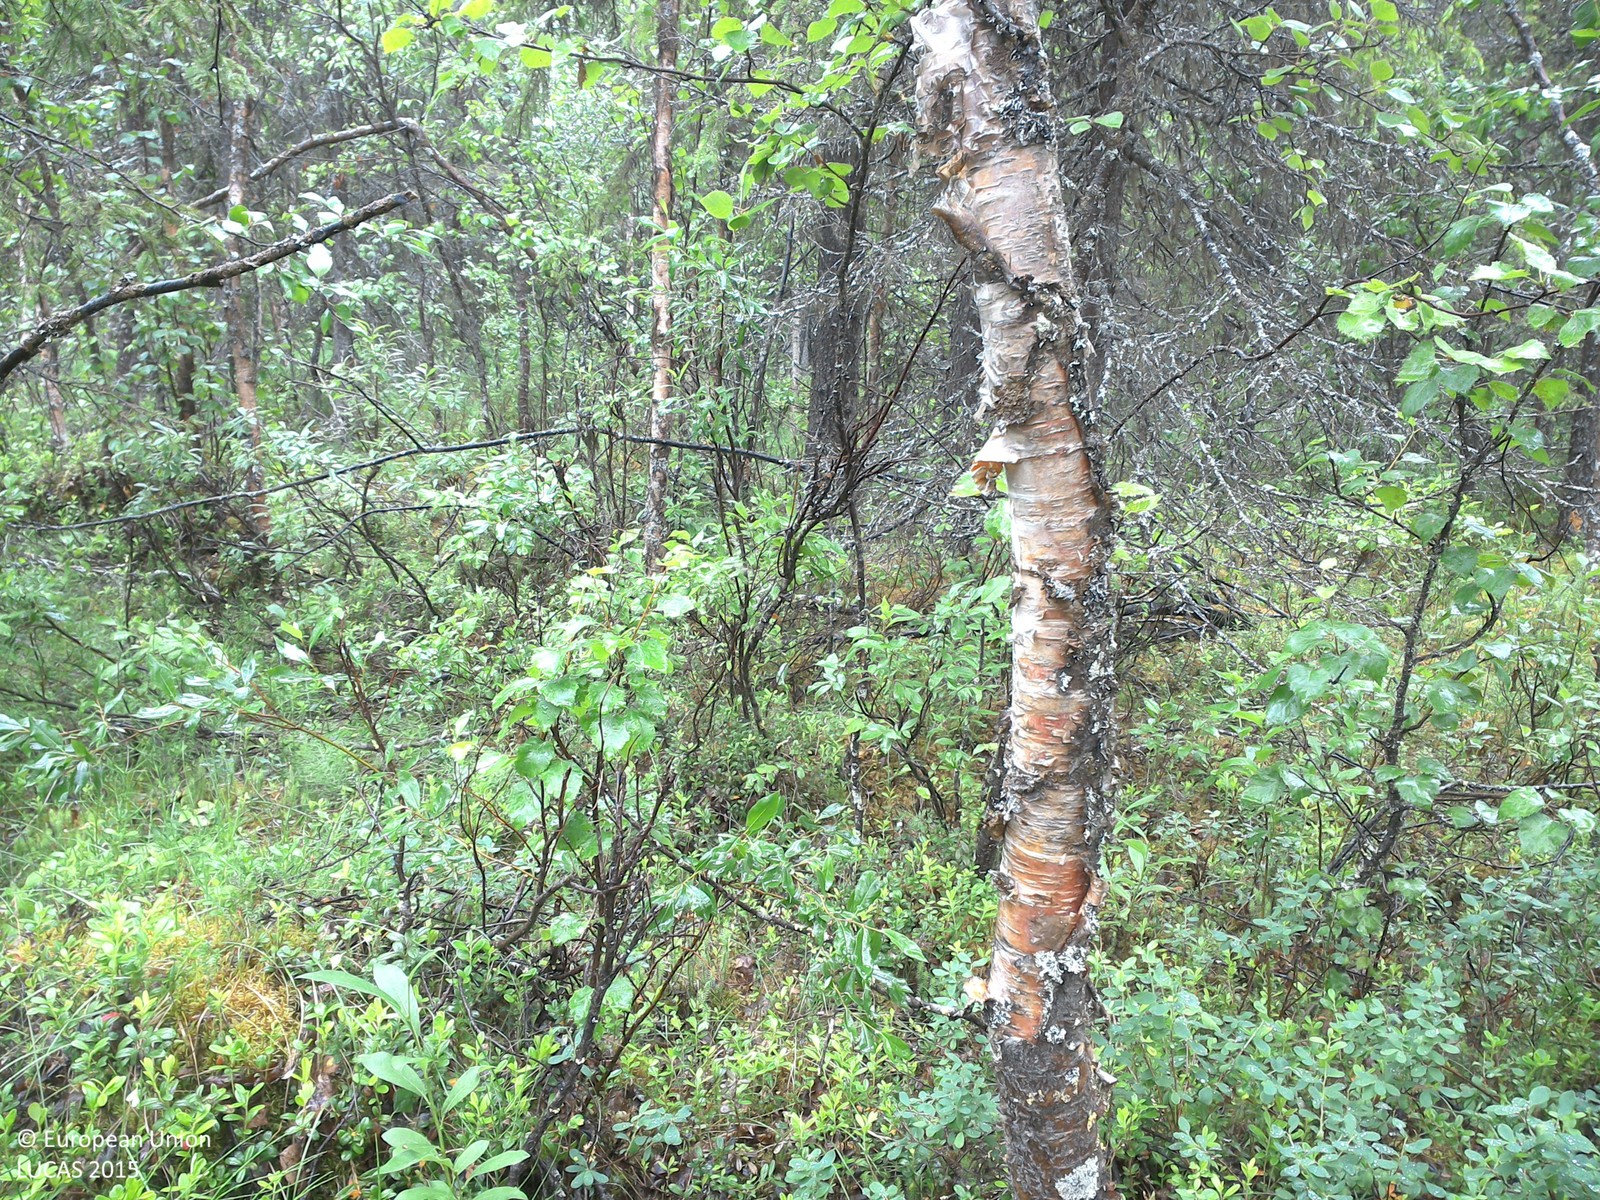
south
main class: Woodland
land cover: Spruce dominated mixed woodland
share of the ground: 25 - 50 %
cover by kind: shrubs 50 %, coniferous forest trees 25 %, broadleaved forest trees 15 %, lichens and mosses 10 %
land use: Forestry
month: July
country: SE
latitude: 67.6632
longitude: 21.4772
